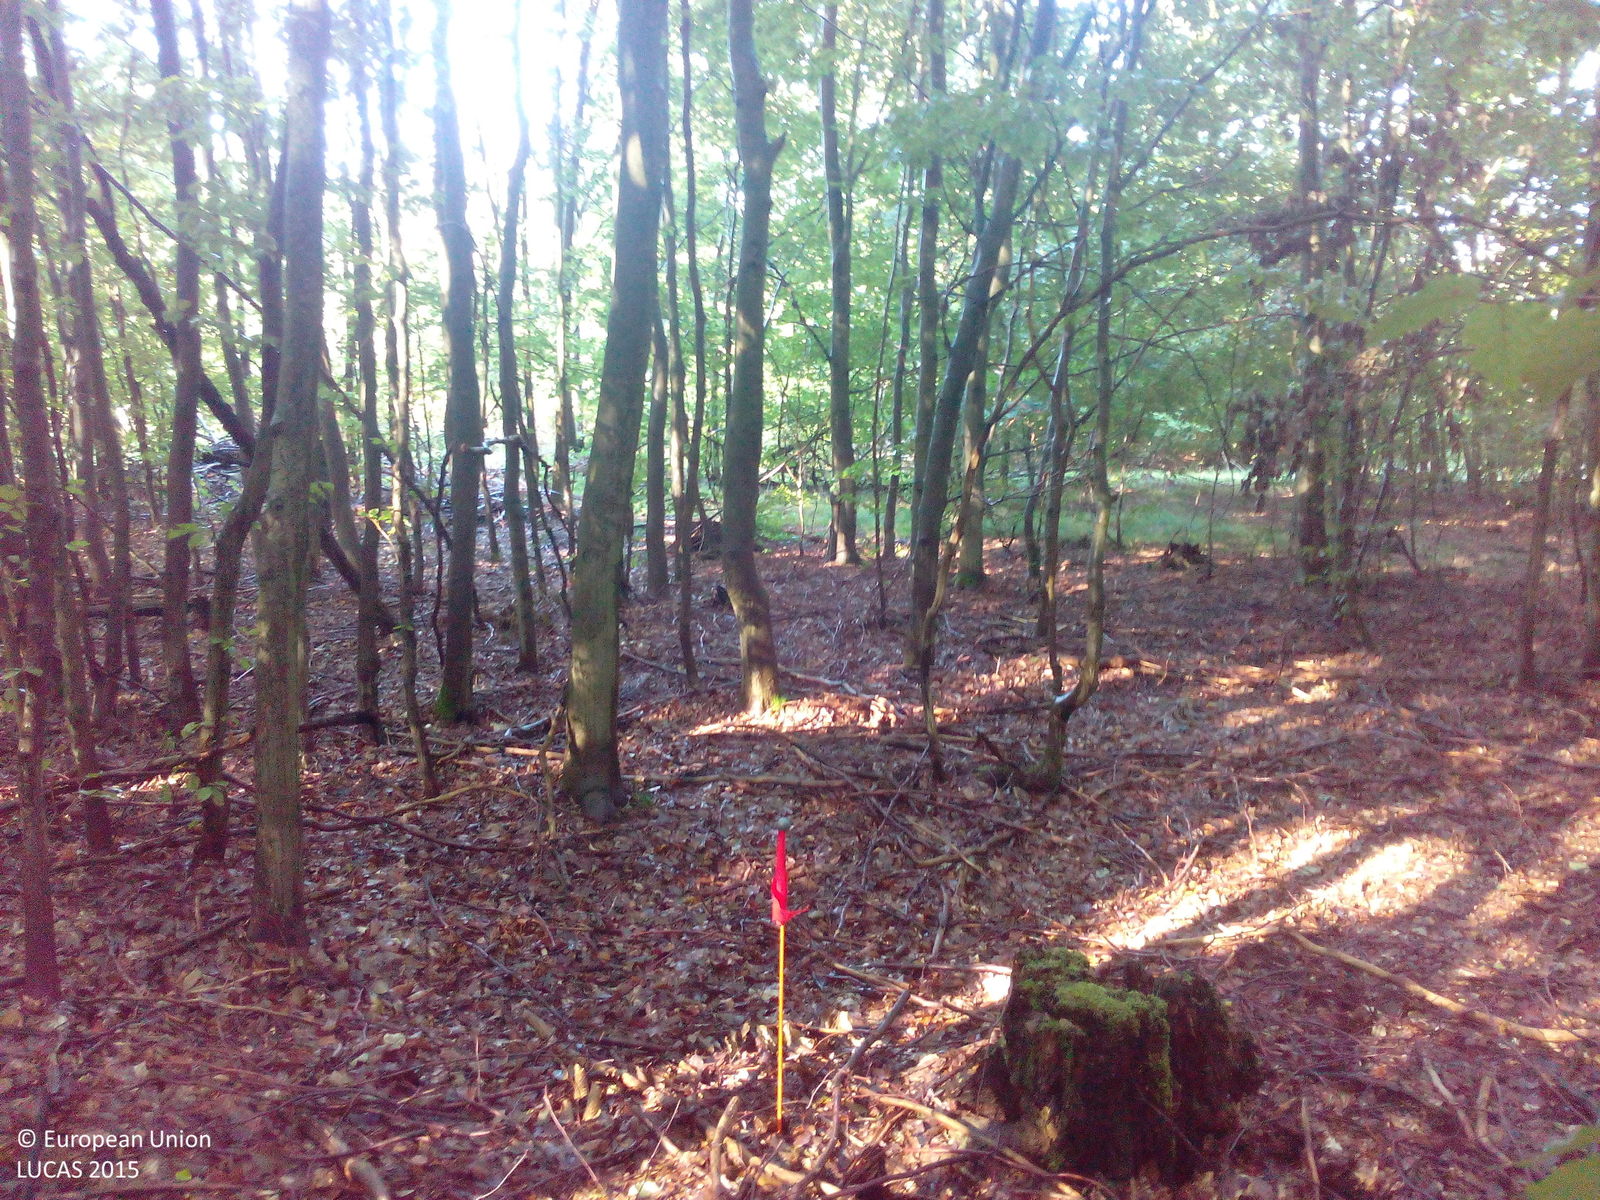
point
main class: Woodland
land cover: Broadleaved woodland
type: beech forest
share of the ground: > 75 %
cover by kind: broadleaved forest trees 100 %
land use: Forestry
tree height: > 5 m
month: August
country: DE
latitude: 51.7086
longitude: 10.9404
